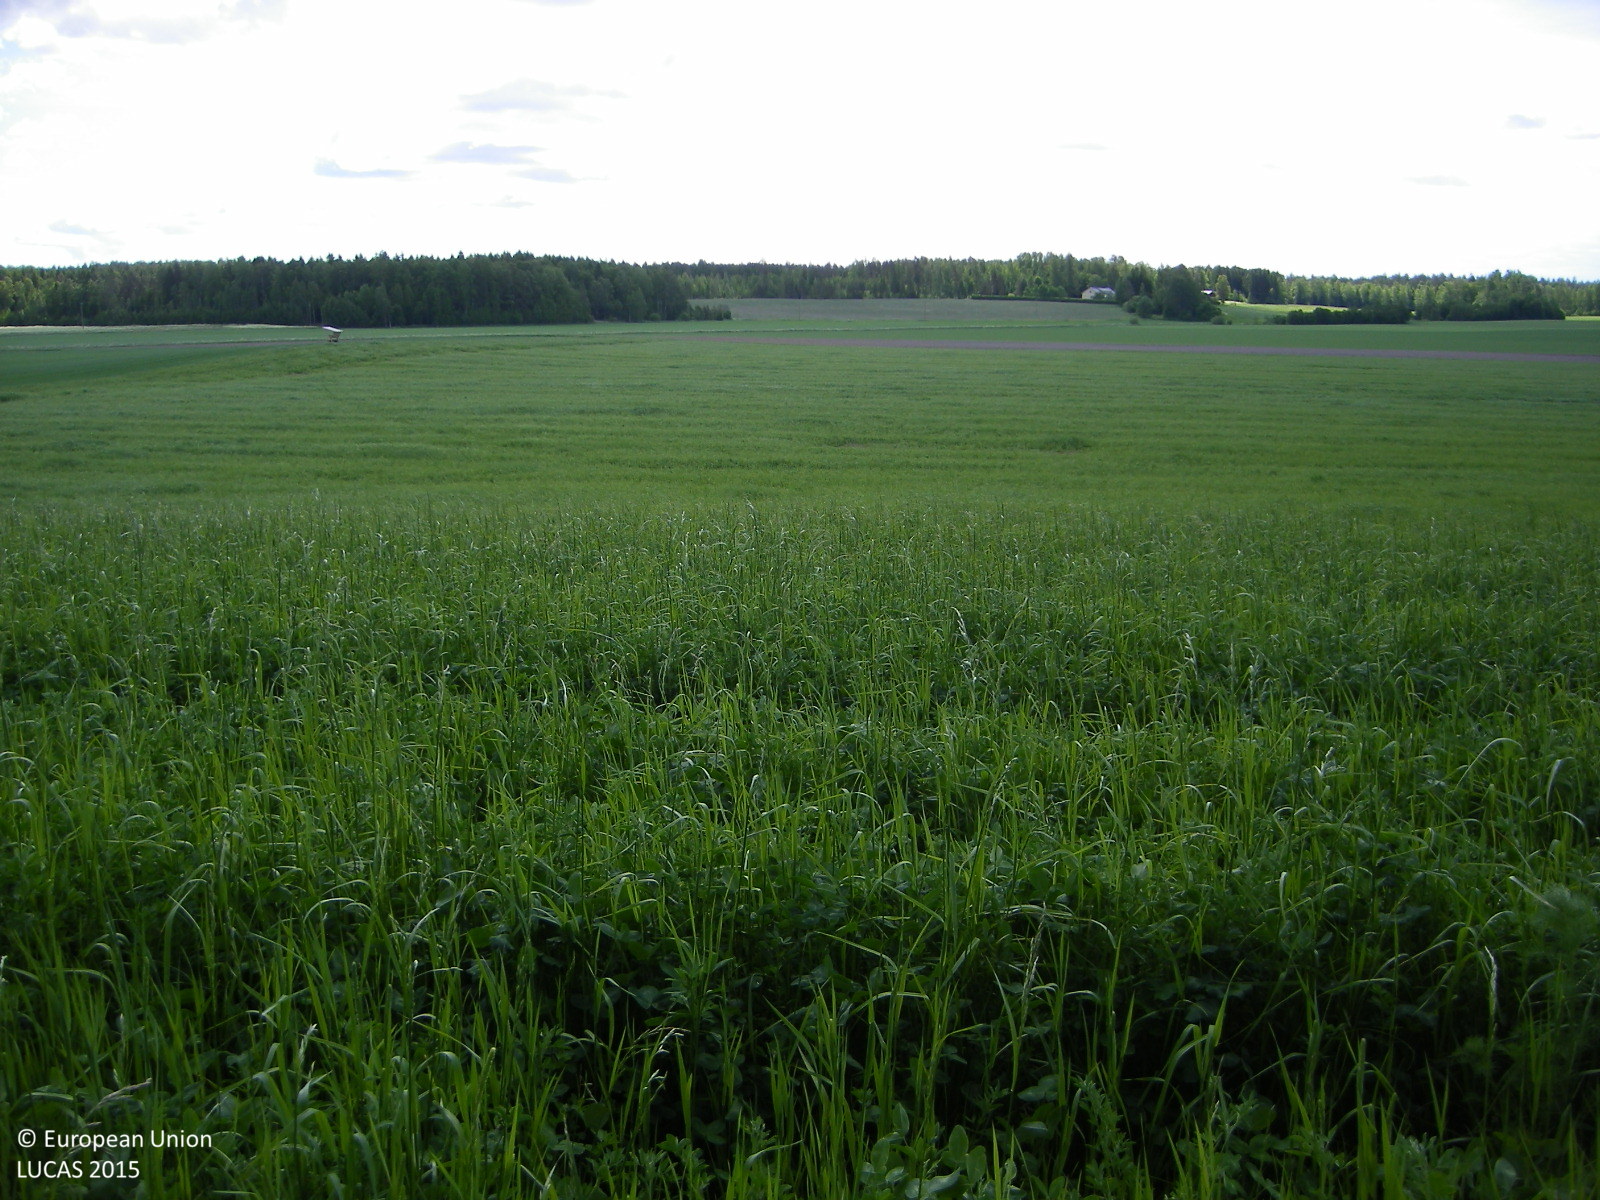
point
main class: Cropland
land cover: Other leguminous and mixtures for fodder
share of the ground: > 75 %
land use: Agriculture (excluding fallow land and kitchen gardens)
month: June
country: FI
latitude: 60.1427
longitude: 24.1292
